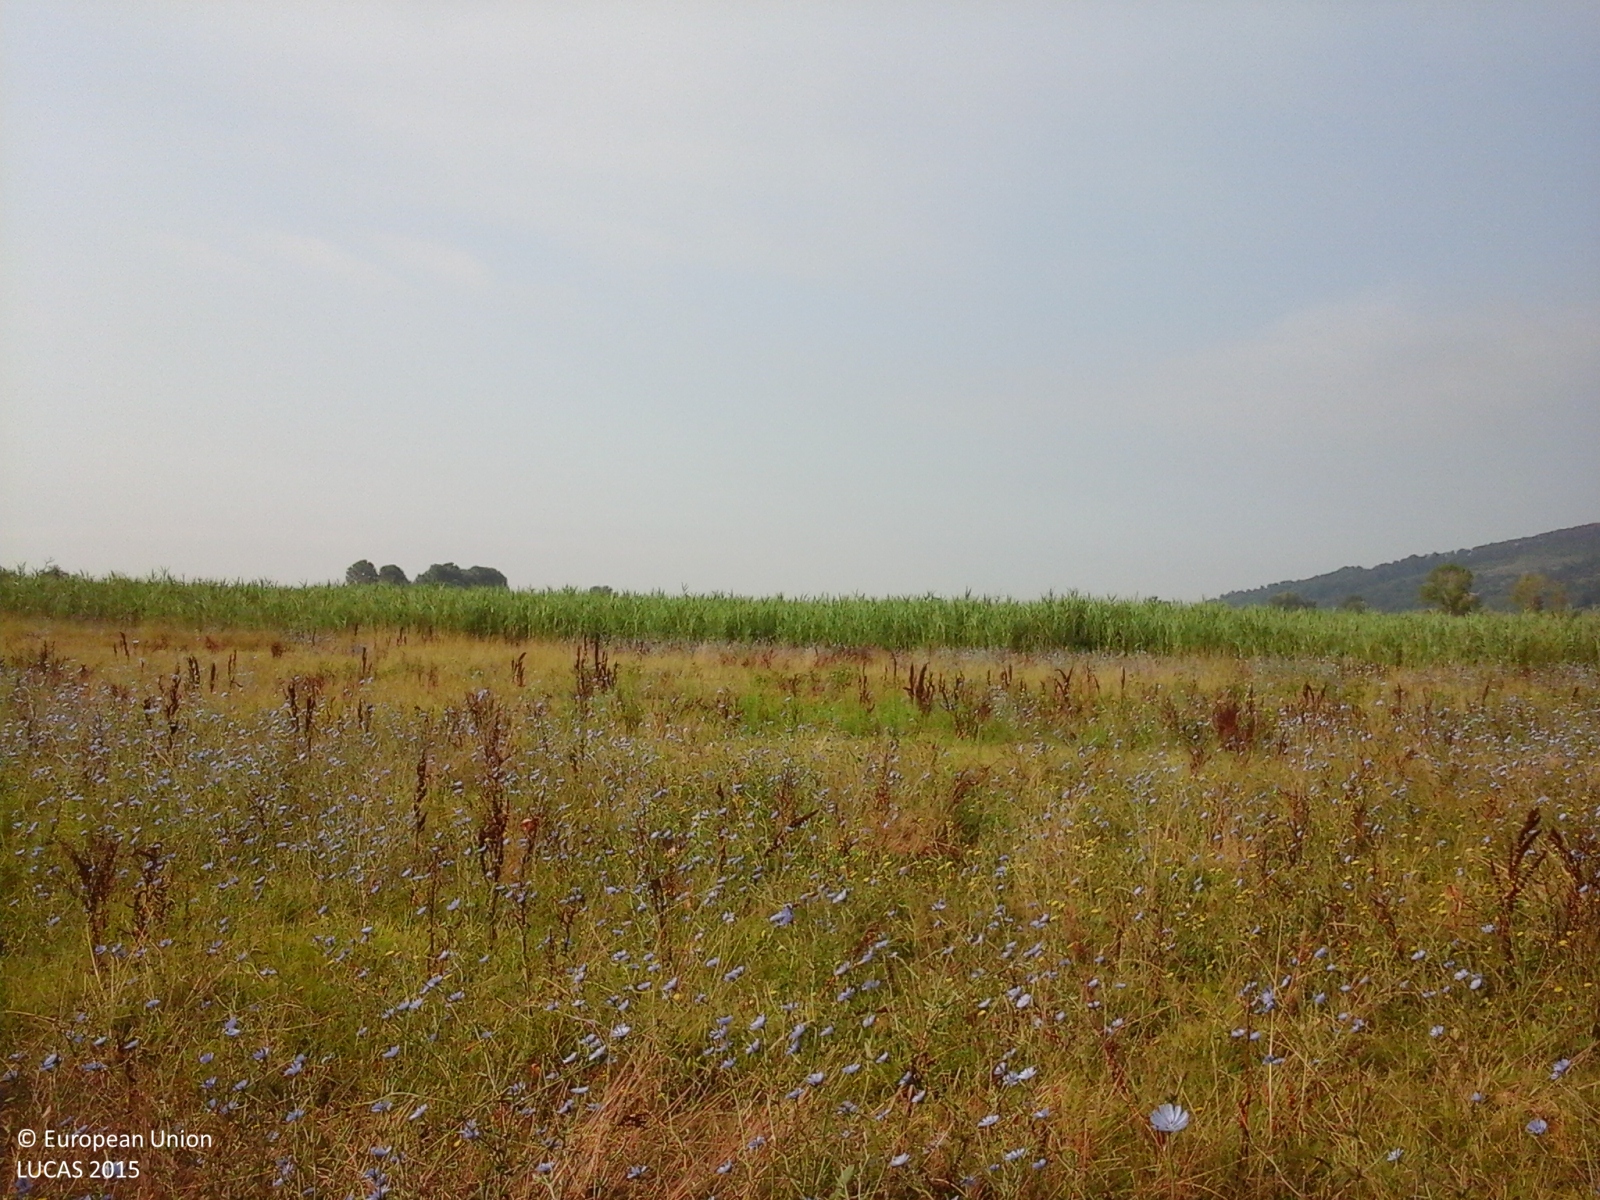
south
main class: Grassland
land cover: Grassland without tree/shrub cover
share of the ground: > 75 %
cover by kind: herbaceous plants 95 %, shrubs 5 %
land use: Agriculture (excluding fallow land and kitchen gardens)
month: July
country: IT
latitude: 43.7533
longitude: 10.6317
